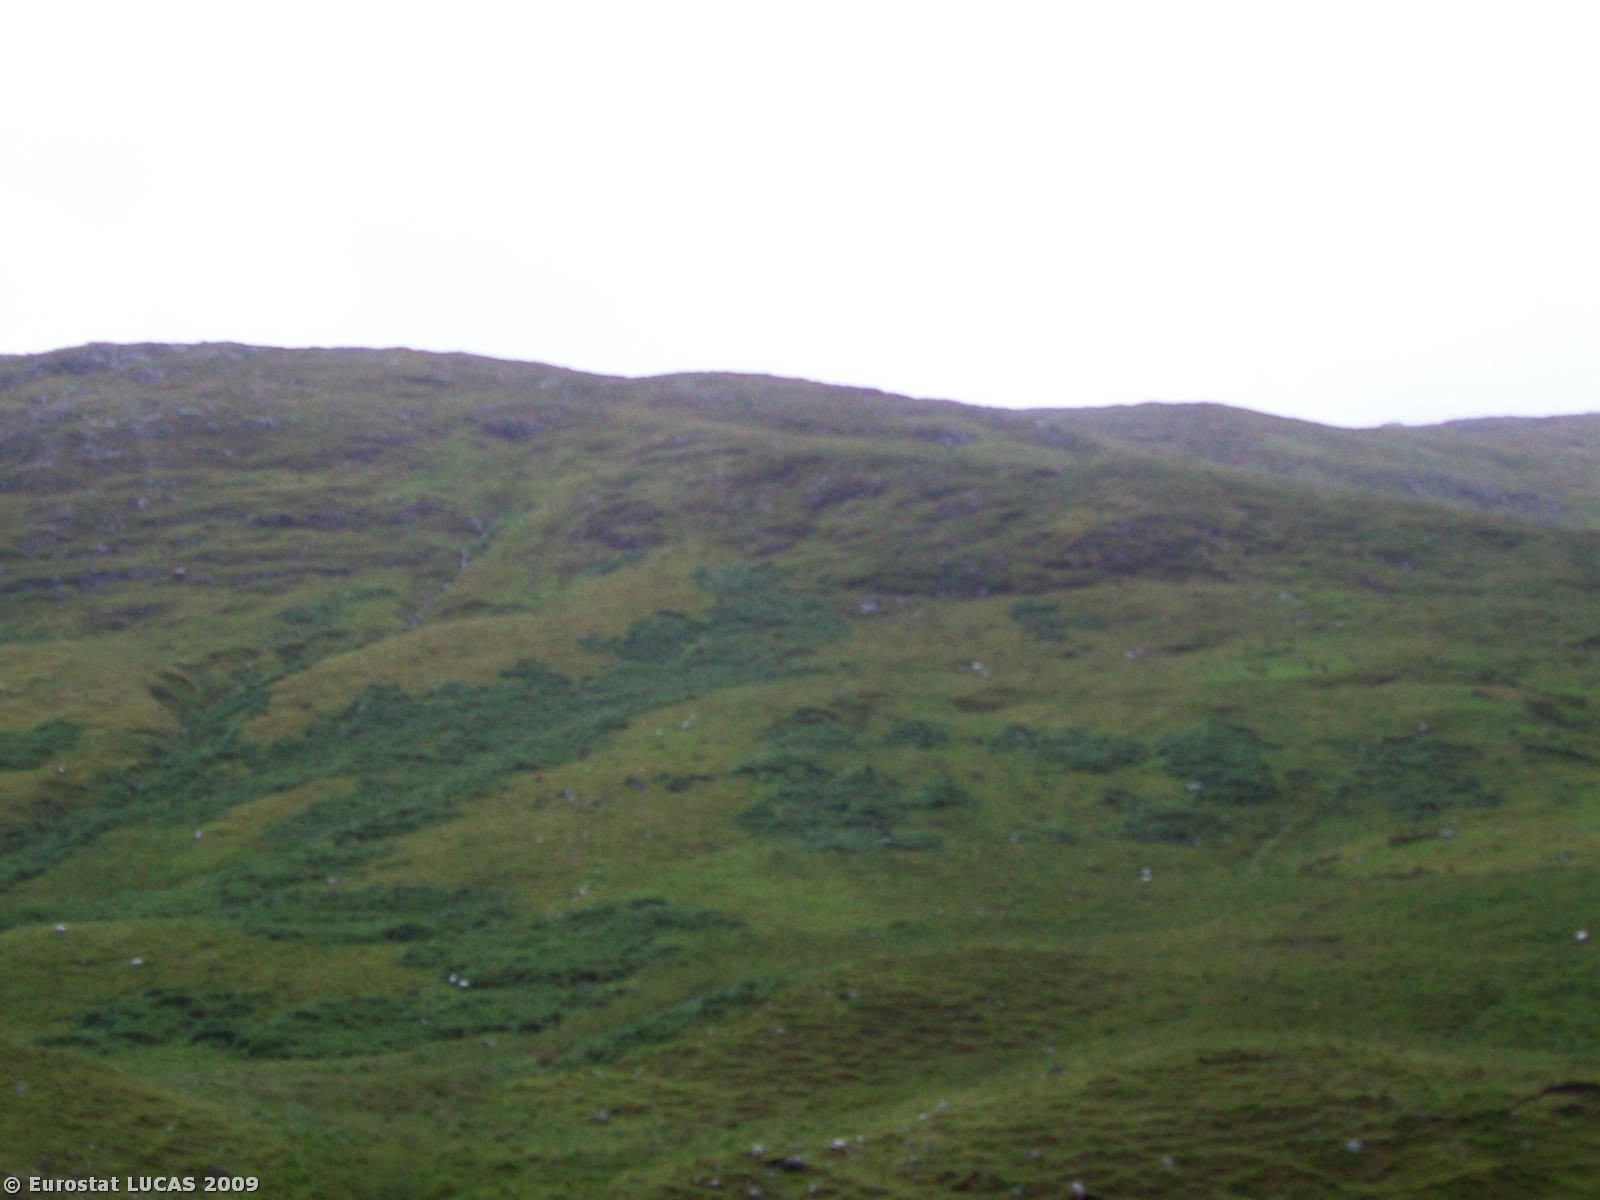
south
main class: Grassland
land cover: Grassland without tree/shrub cover
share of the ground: > 75 %
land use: Agriculture (excluding fallow land and kitchen gardens)
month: July
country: IE
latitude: 53.5309
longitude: -9.5293
